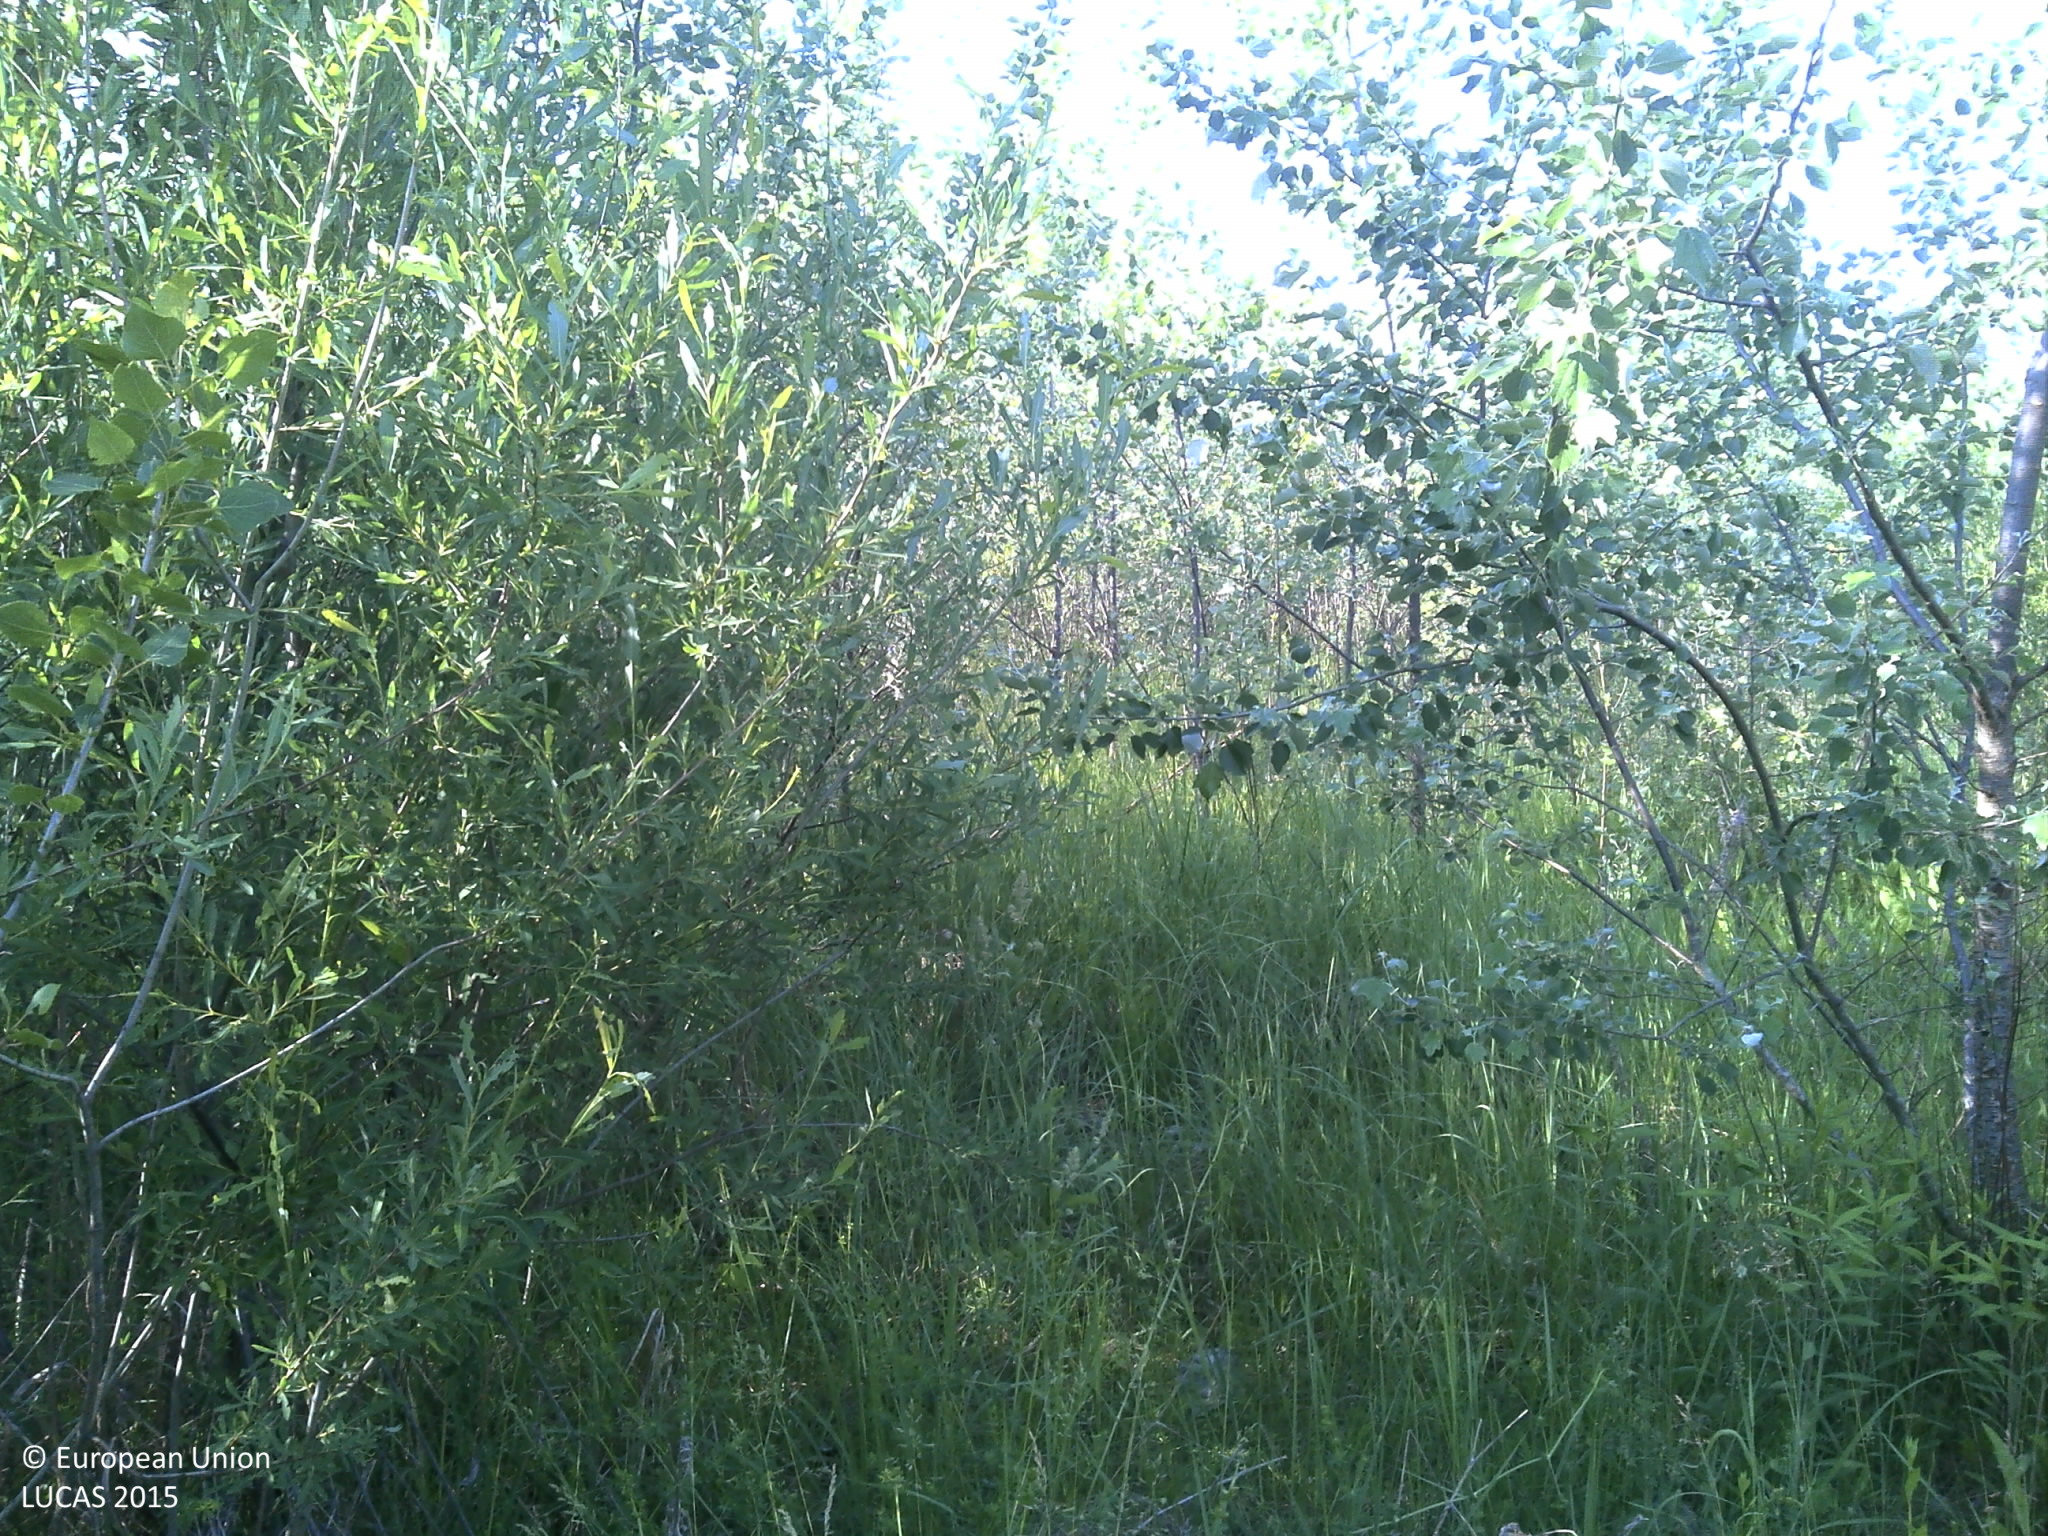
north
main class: Grassland
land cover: Grassland with sparse tree/shrub cover
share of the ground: > 75 %
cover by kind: herbaceous plants 85 %, shrubs 10 %, broadleaved forest trees 5 %
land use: Semi-natural and natural areas not in use
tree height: < 5 m
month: May
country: HR
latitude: 45.5472
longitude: 18.6531
